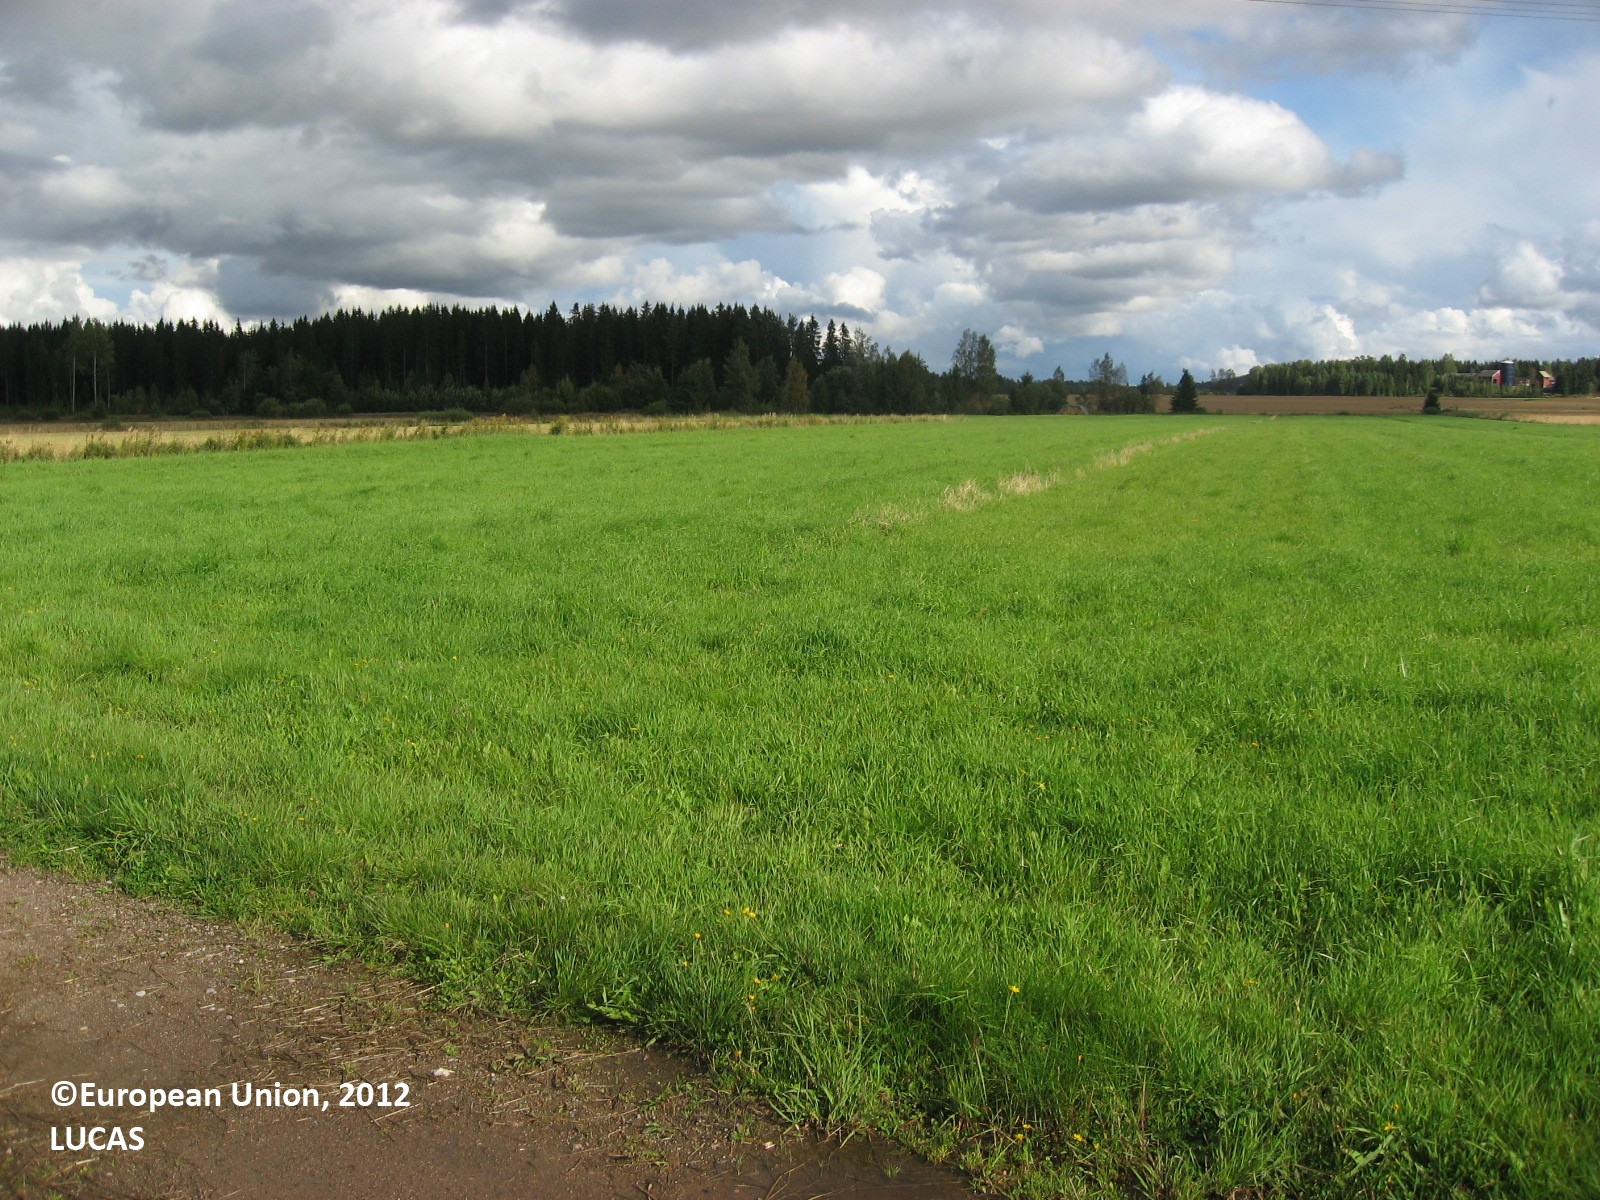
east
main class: Cropland
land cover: Temporary grasslands
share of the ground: > 75 %
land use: Agriculture (excluding fallow land and kitchen gardens)
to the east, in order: Temporary grasslands; Paved roads, cycling and walking lanes; Temporary grasslands; Electric lines; Temporary grasslands; Grass margins; Ditches and canals; Grass margins; Temporary grasslands; Grass margins; Temporary grasslands
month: September
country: FI
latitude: 60.9147
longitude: 25.1852
